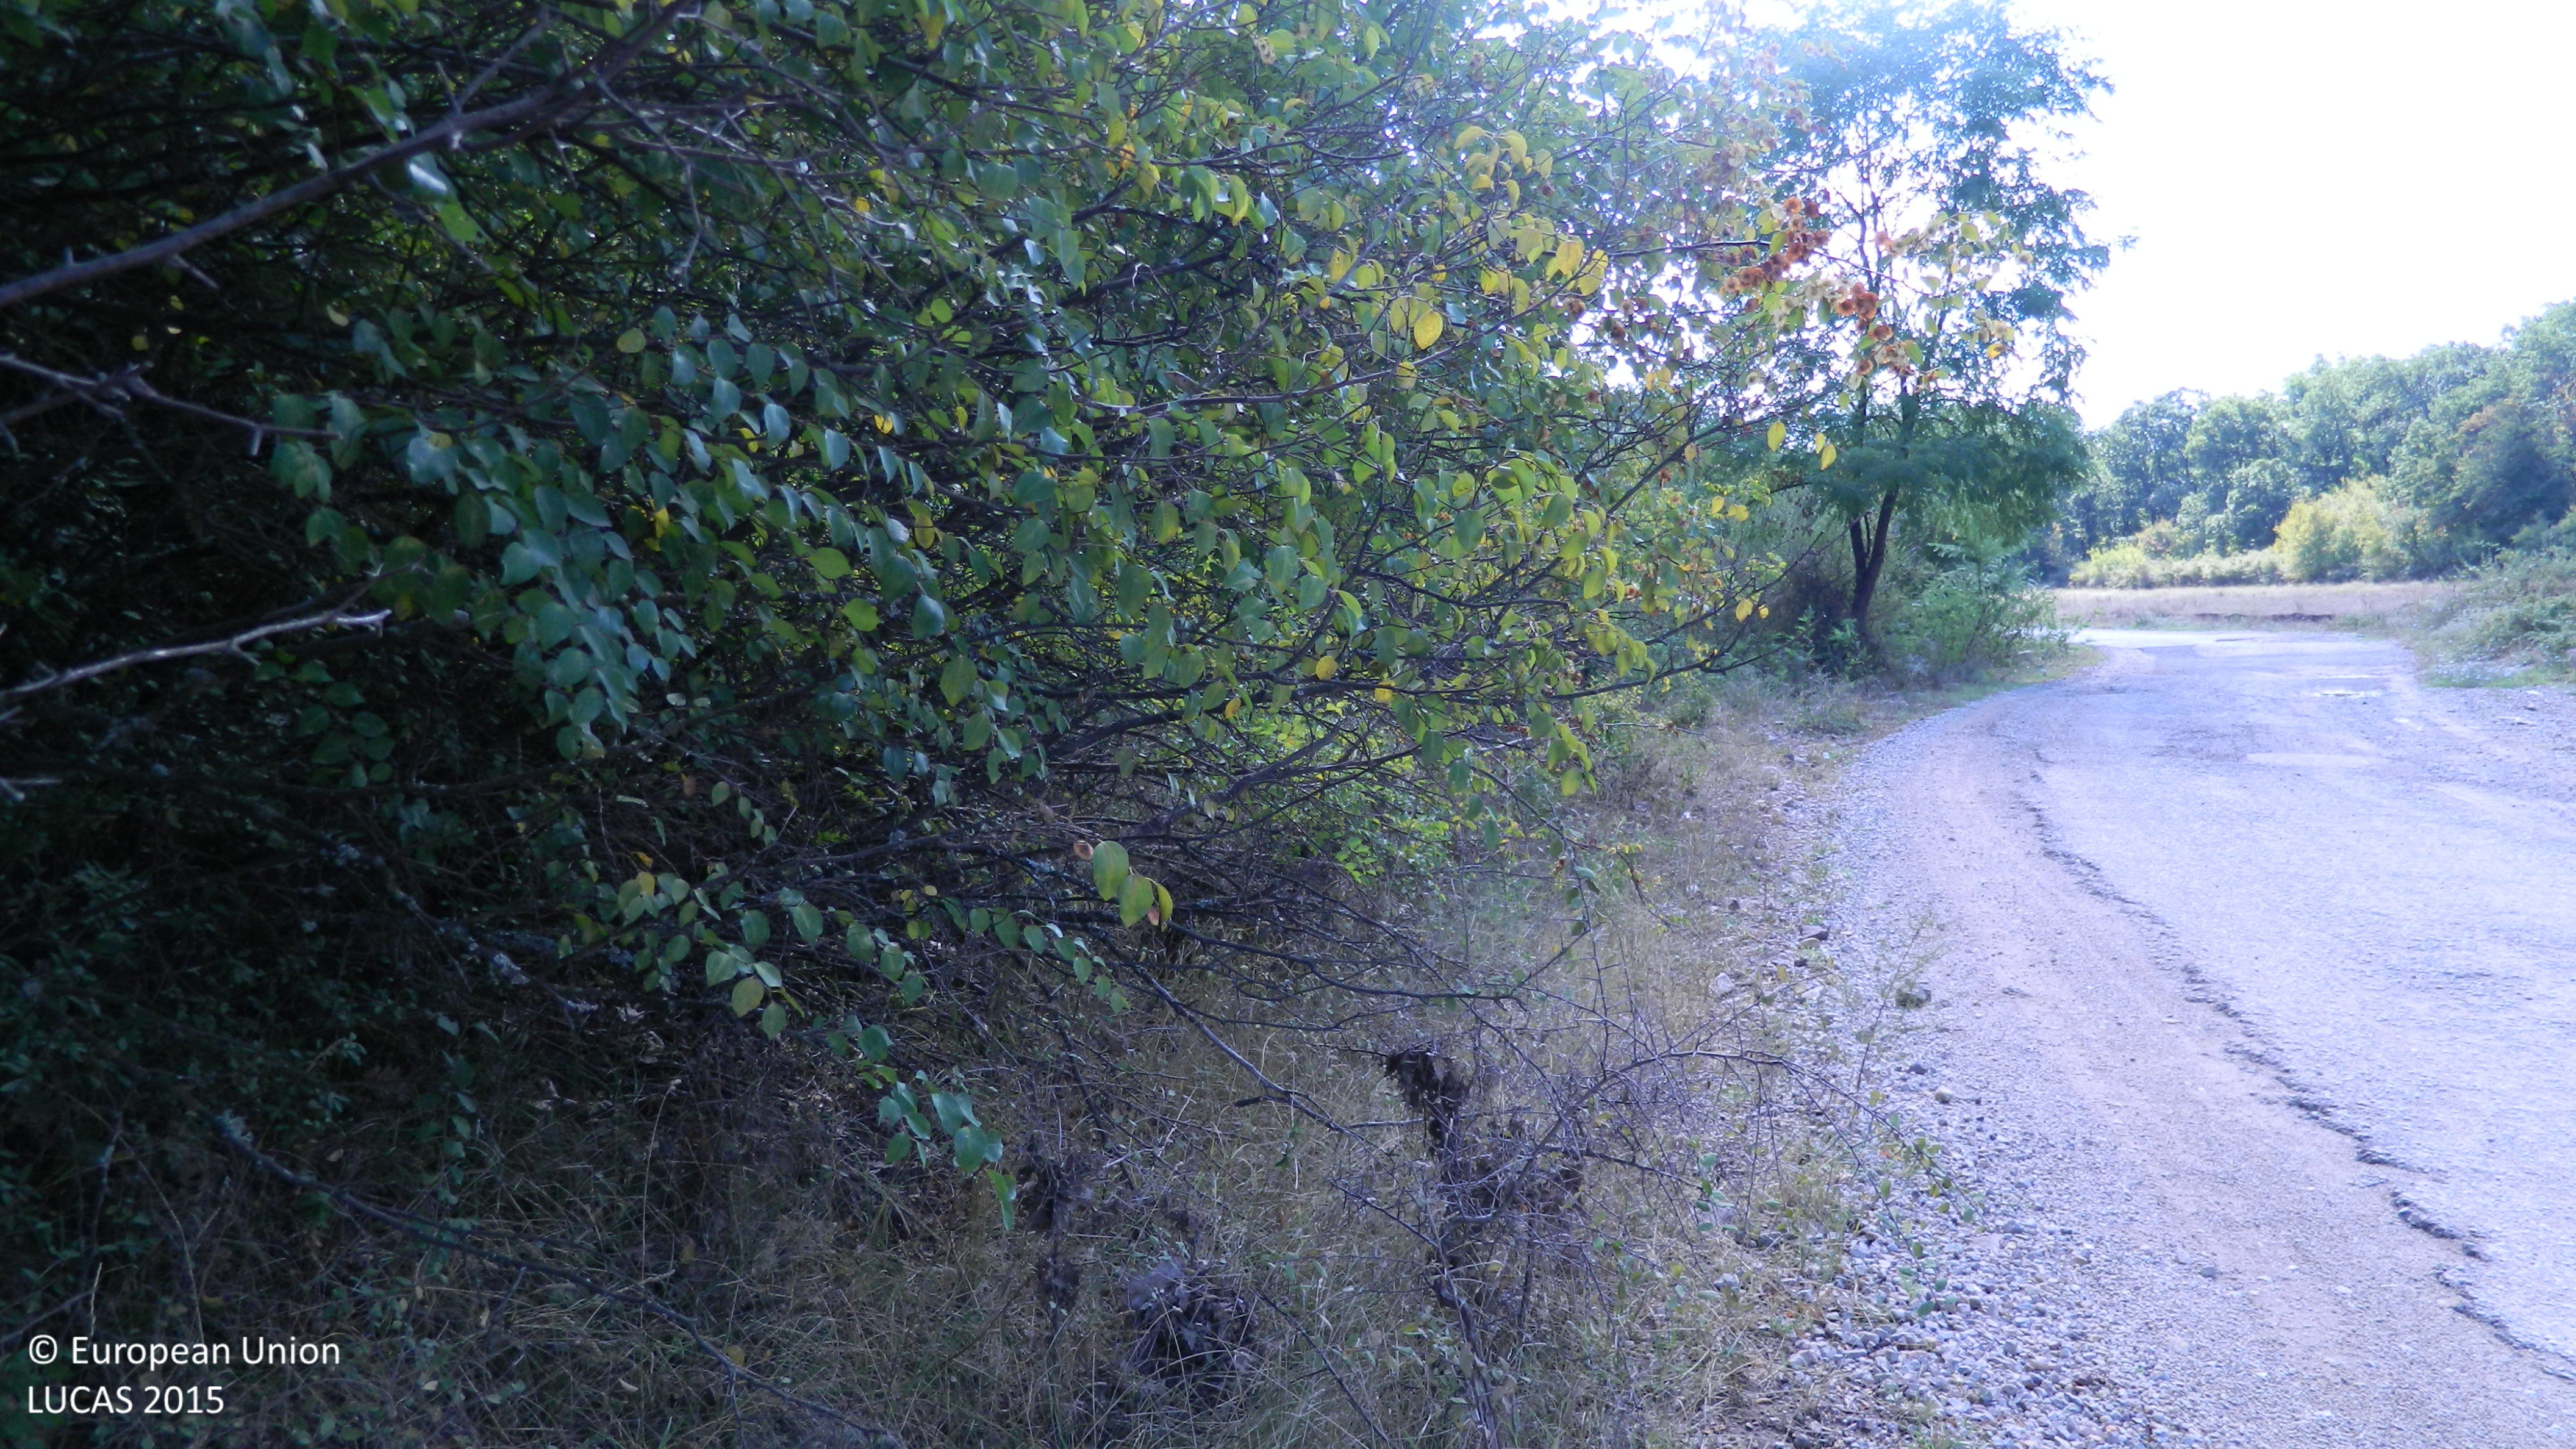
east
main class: Woodland
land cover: Broadleaved woodland
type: mesophytic deciduous forest
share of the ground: > 75 %
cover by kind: broadleaved forest trees 90 %, shrubs 5 %, herbaceous plants 5 %
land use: Forestry
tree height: > 5 m
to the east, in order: Broadleaved woodland; Rock outcrops; Shrubland with sparse tree cover; Rivers and streams; Broadleaved woodland; Rivers and streams; Broadleaved woodland; Rocks and stones; Broadleaved woodland; Tracks; Broadleaved woodland; Rivers and streams; Broadleaved woodland
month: August
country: BG
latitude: 41.6881
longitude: 25.8663
